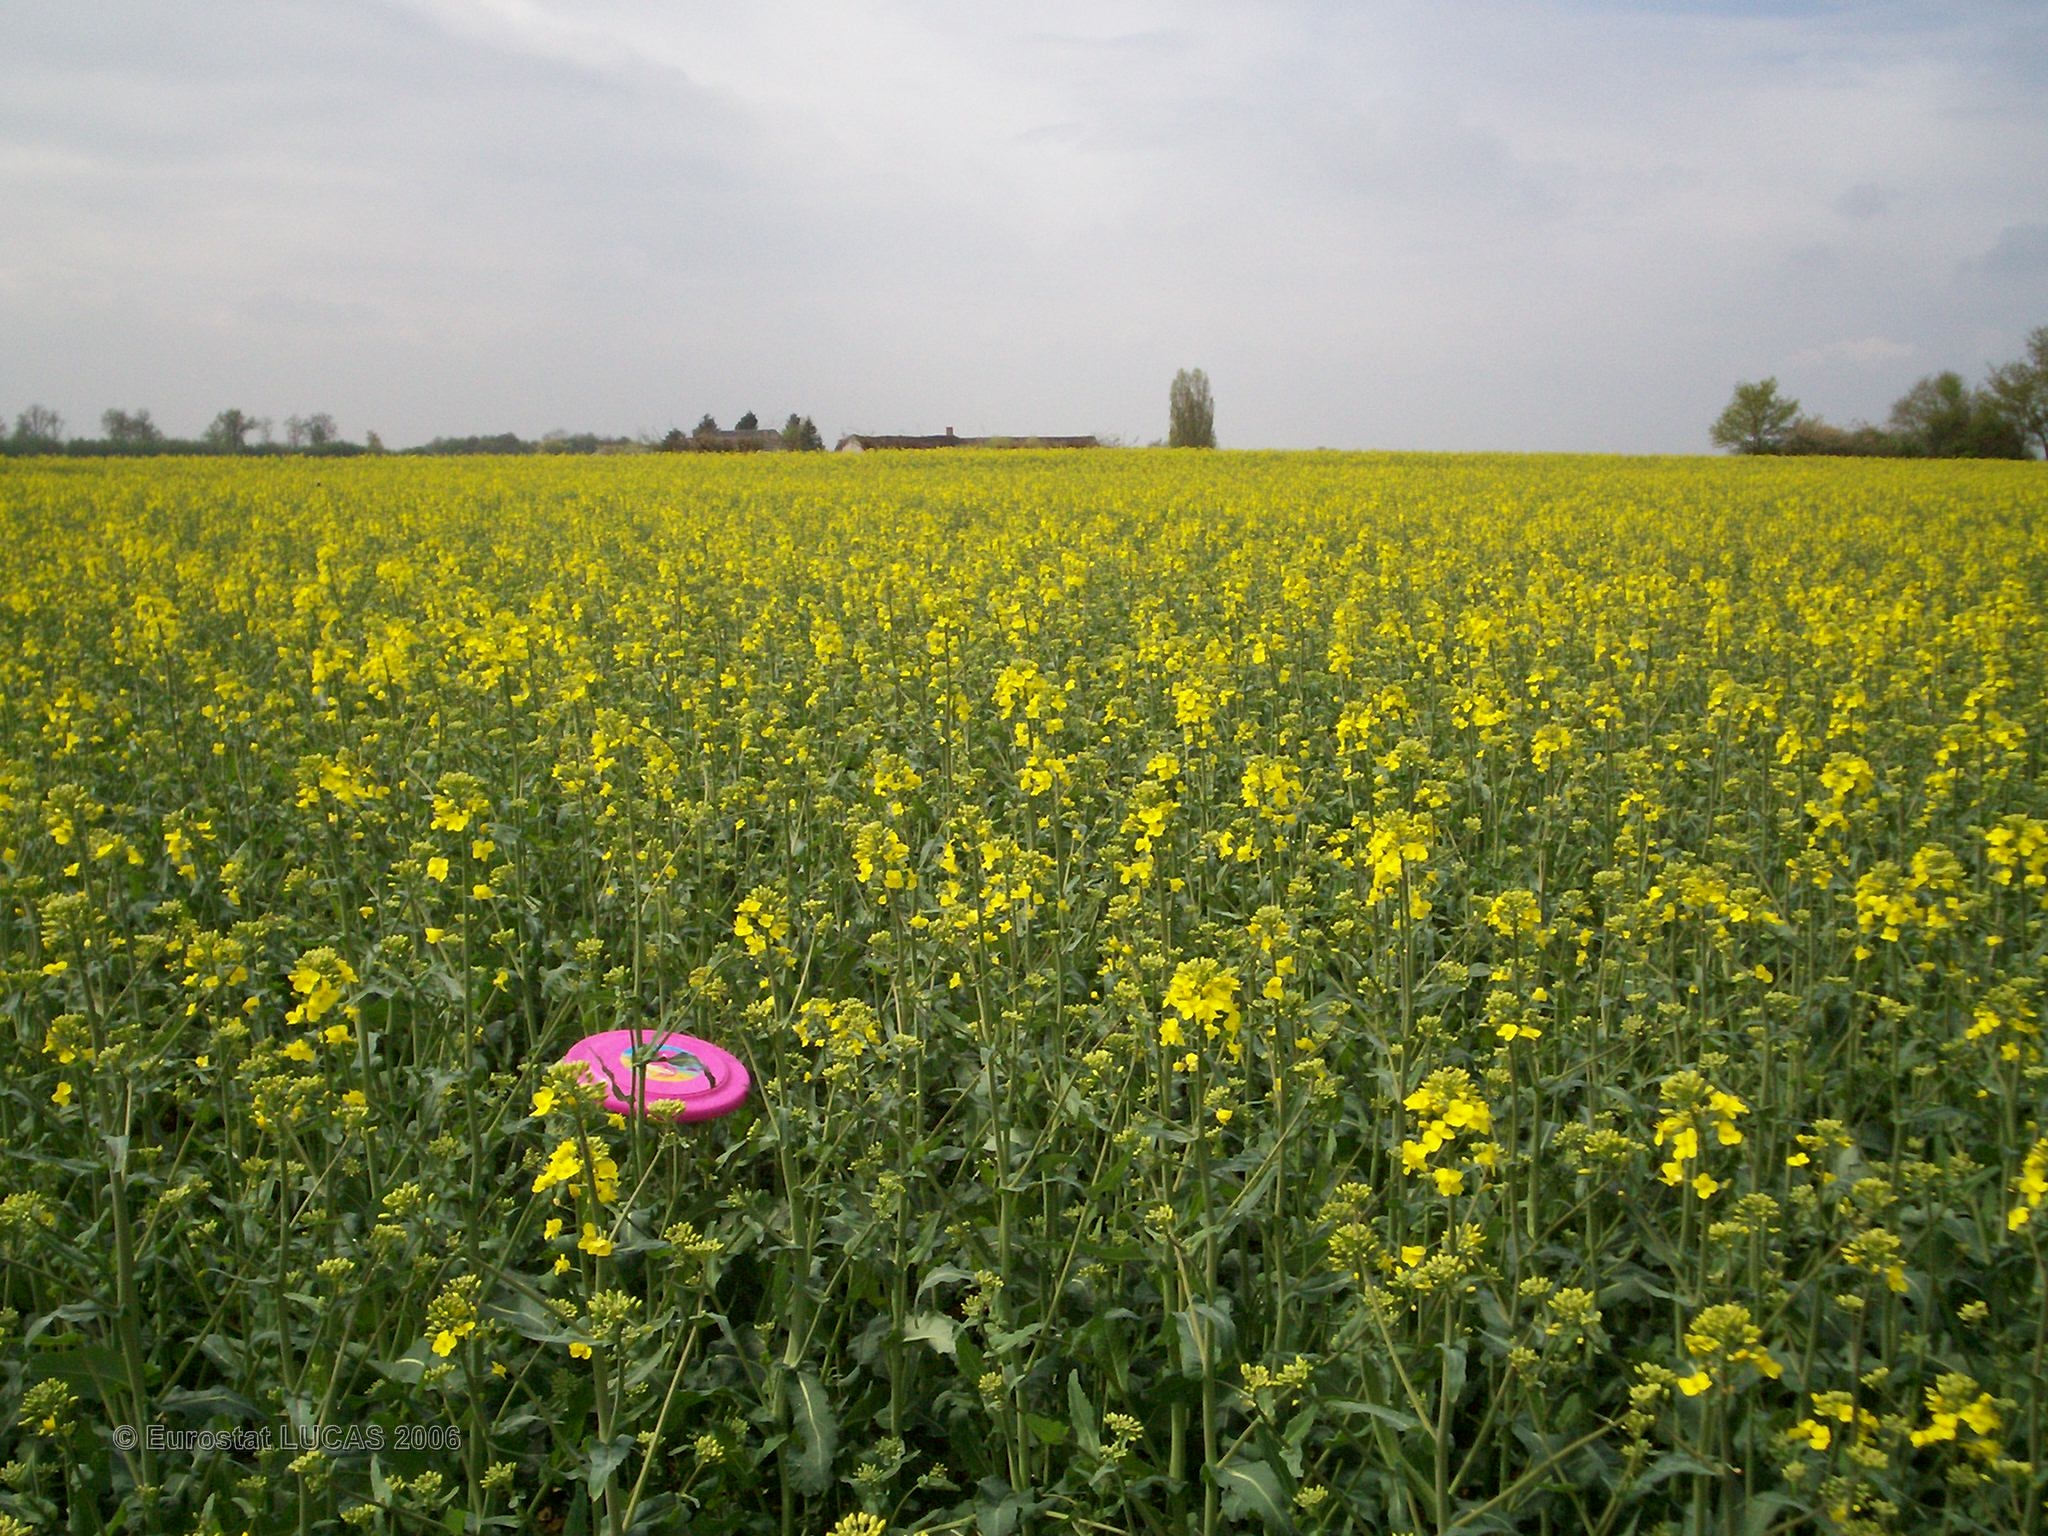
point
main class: Cropland
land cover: Rape and turnip rape
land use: Agriculture (excluding fallow land and kitchen gardens)
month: April
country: FR
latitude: 47.8370
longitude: 2.9789
